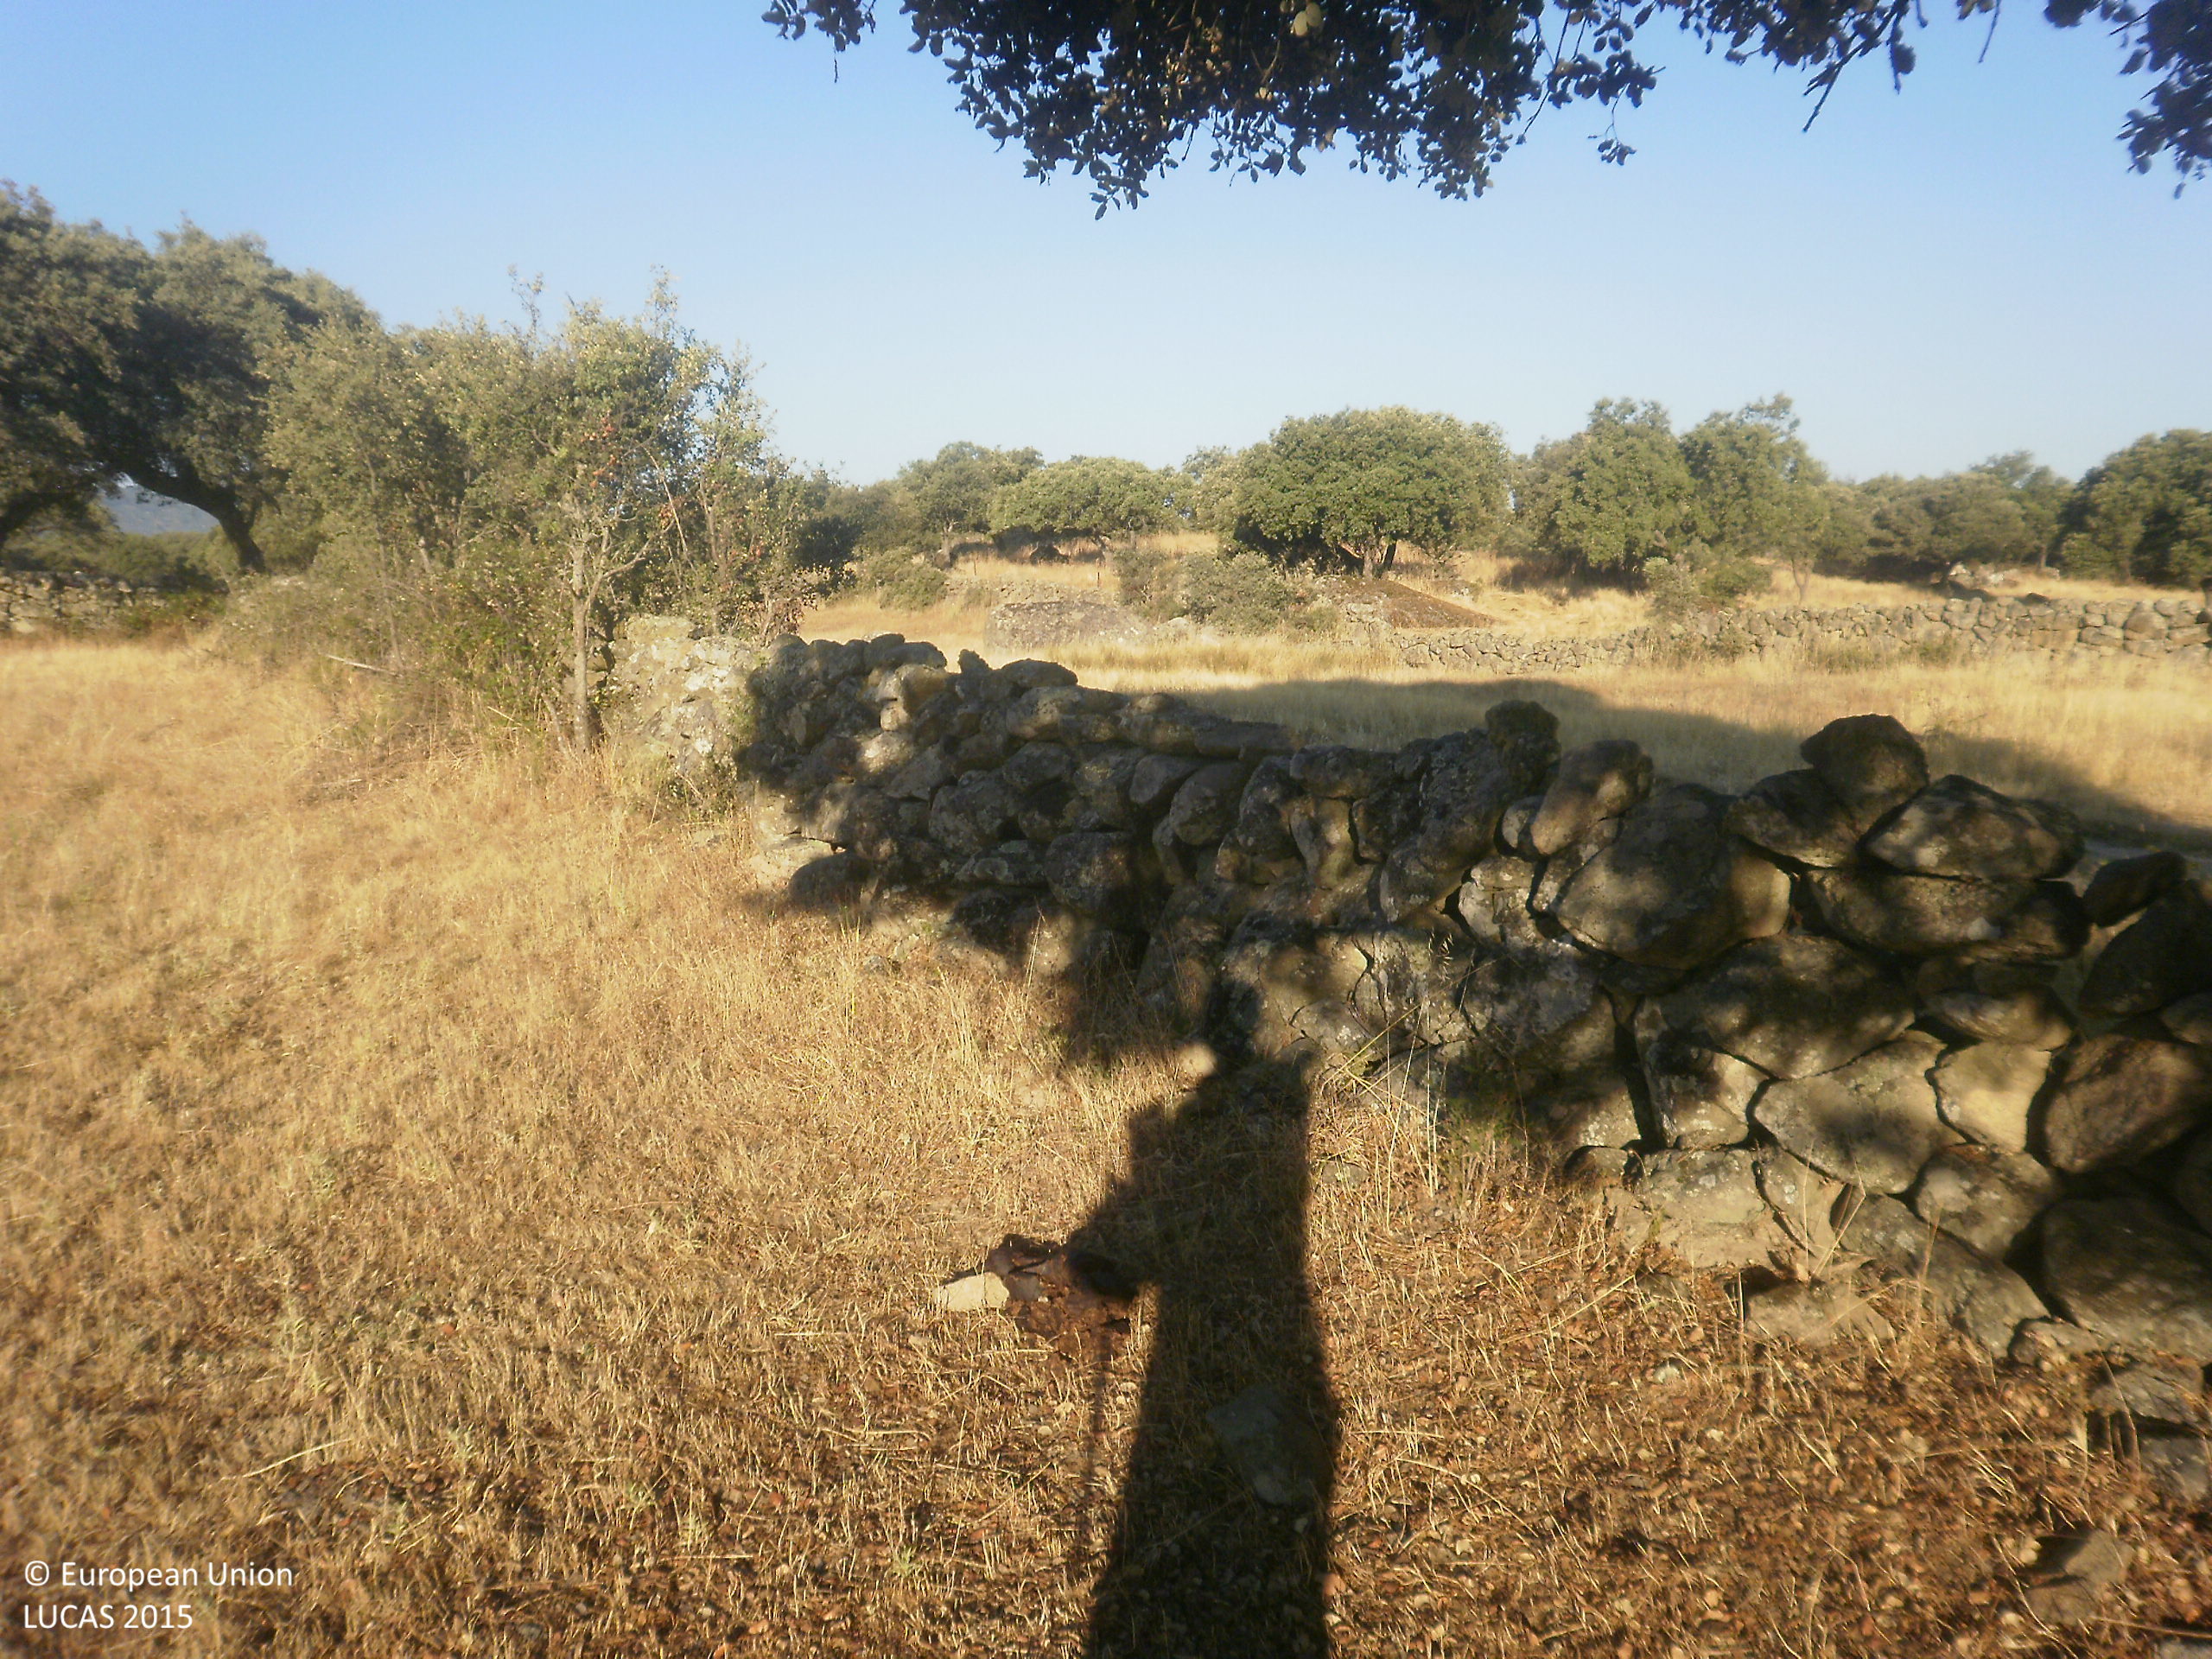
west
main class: Woodland
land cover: Broadleaved woodland
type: broadleaved evergreen forest
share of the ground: 10 - 25 %
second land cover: Grassland without tree/shrub cover
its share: 50 - 75 %
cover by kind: herbaceous plants 90 %, broadleaved forest trees 10 %
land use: Forestry
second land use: Agriculture (excluding fallow land and kitchen gardens)
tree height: > 5 m
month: June
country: ES
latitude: 39.2867
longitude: -6.0459
